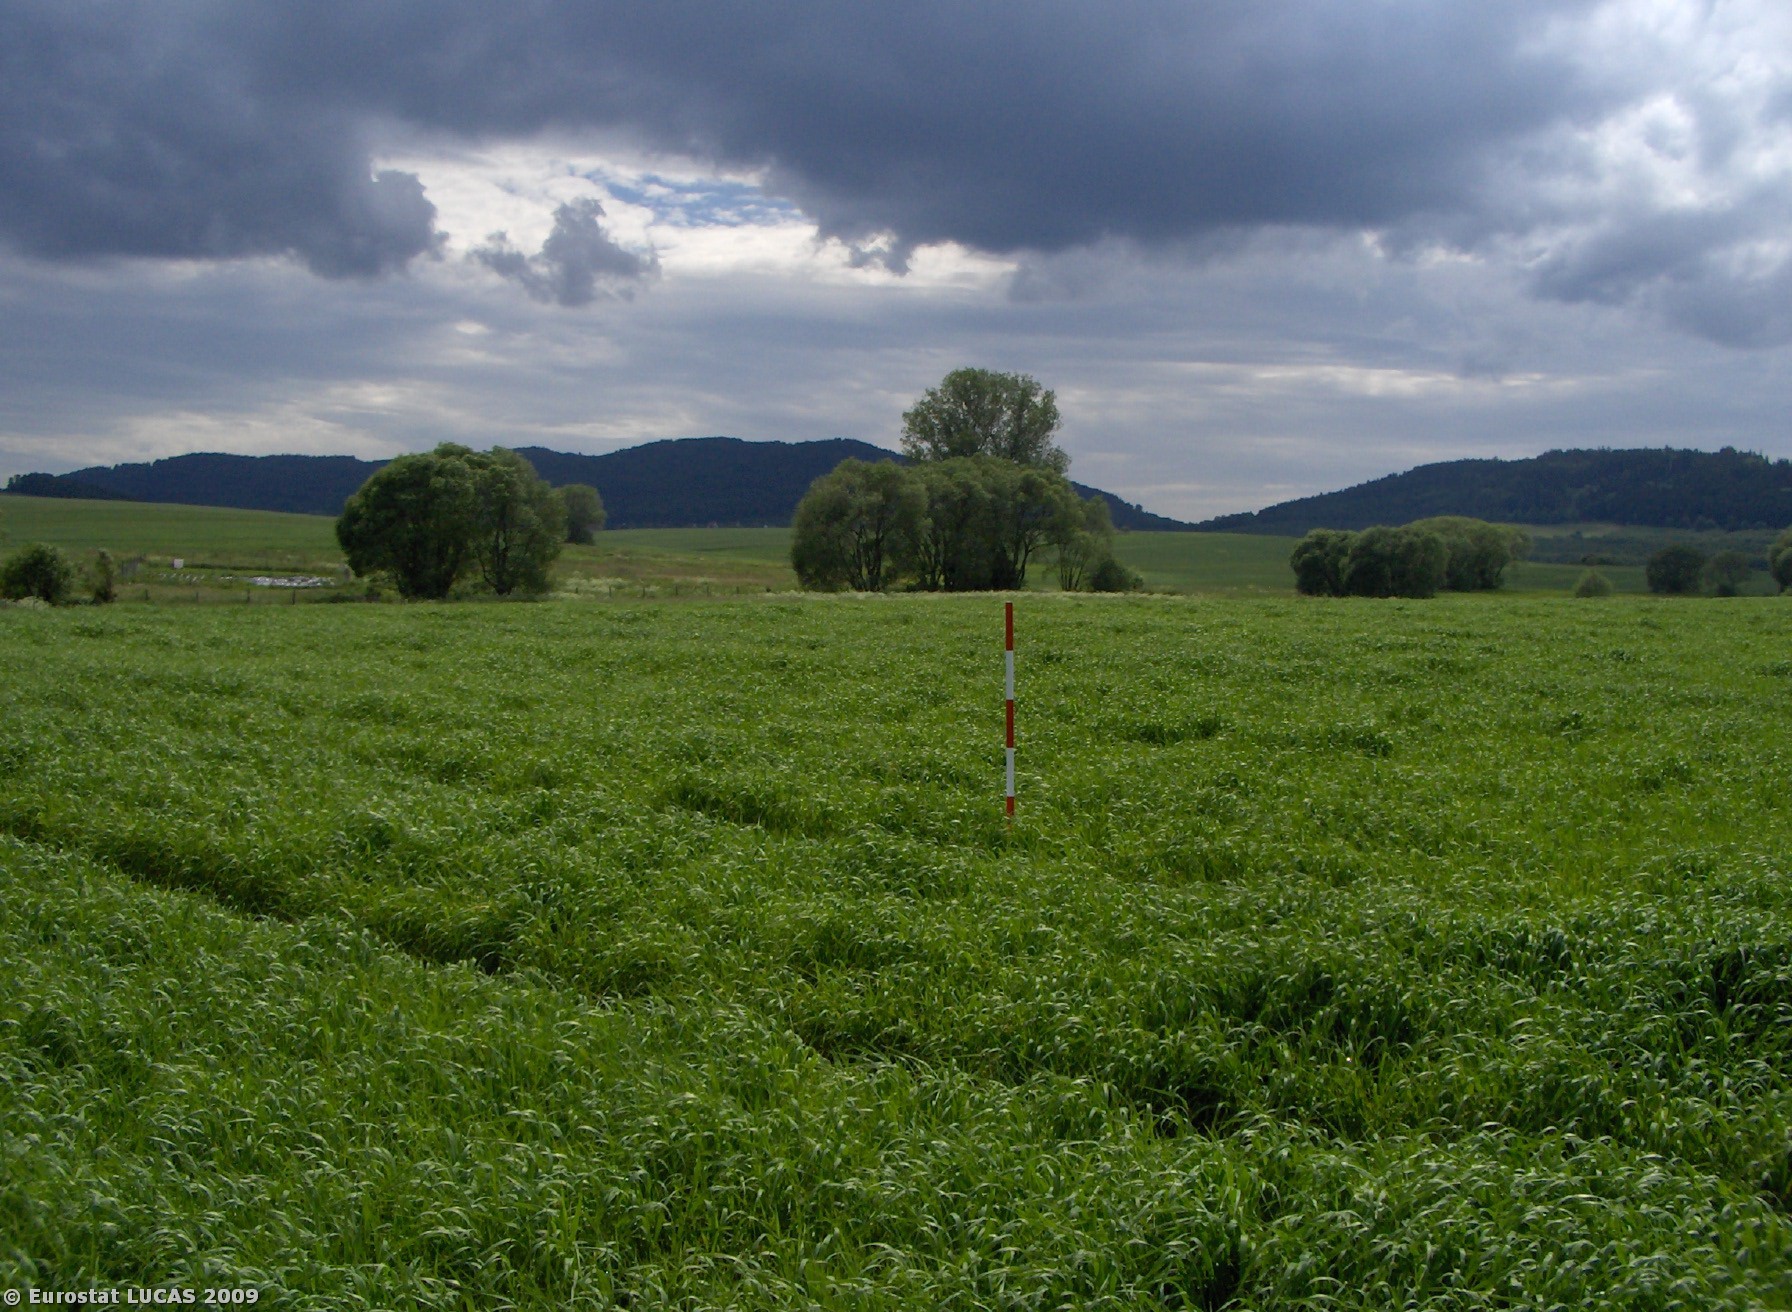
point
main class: Cropland
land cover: Barley
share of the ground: > 75 %
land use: Agriculture (excluding fallow land and kitchen gardens)
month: June
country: CZ
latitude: 48.9915
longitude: 14.1689
